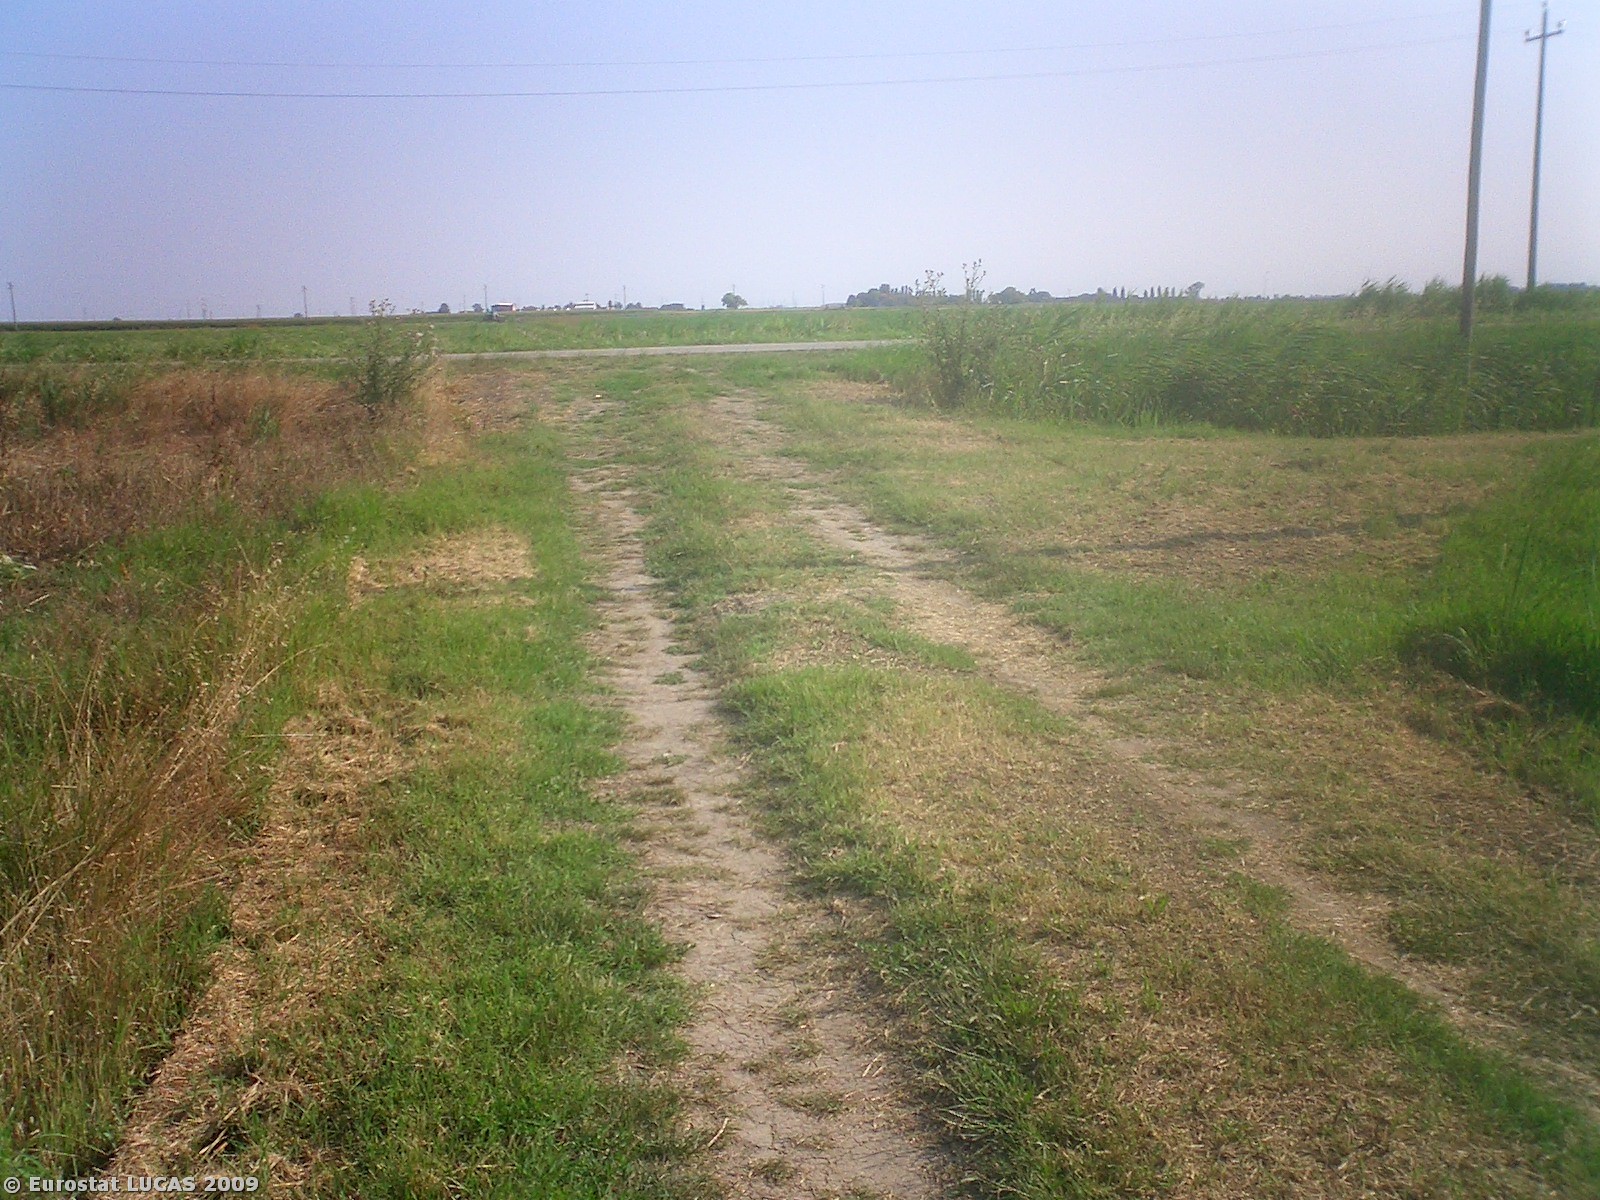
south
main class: Cropland
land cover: Rice
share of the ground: > 75 %
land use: Agriculture (excluding fallow land and kitchen gardens)
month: July
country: IT
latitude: 44.8888
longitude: 12.0852
